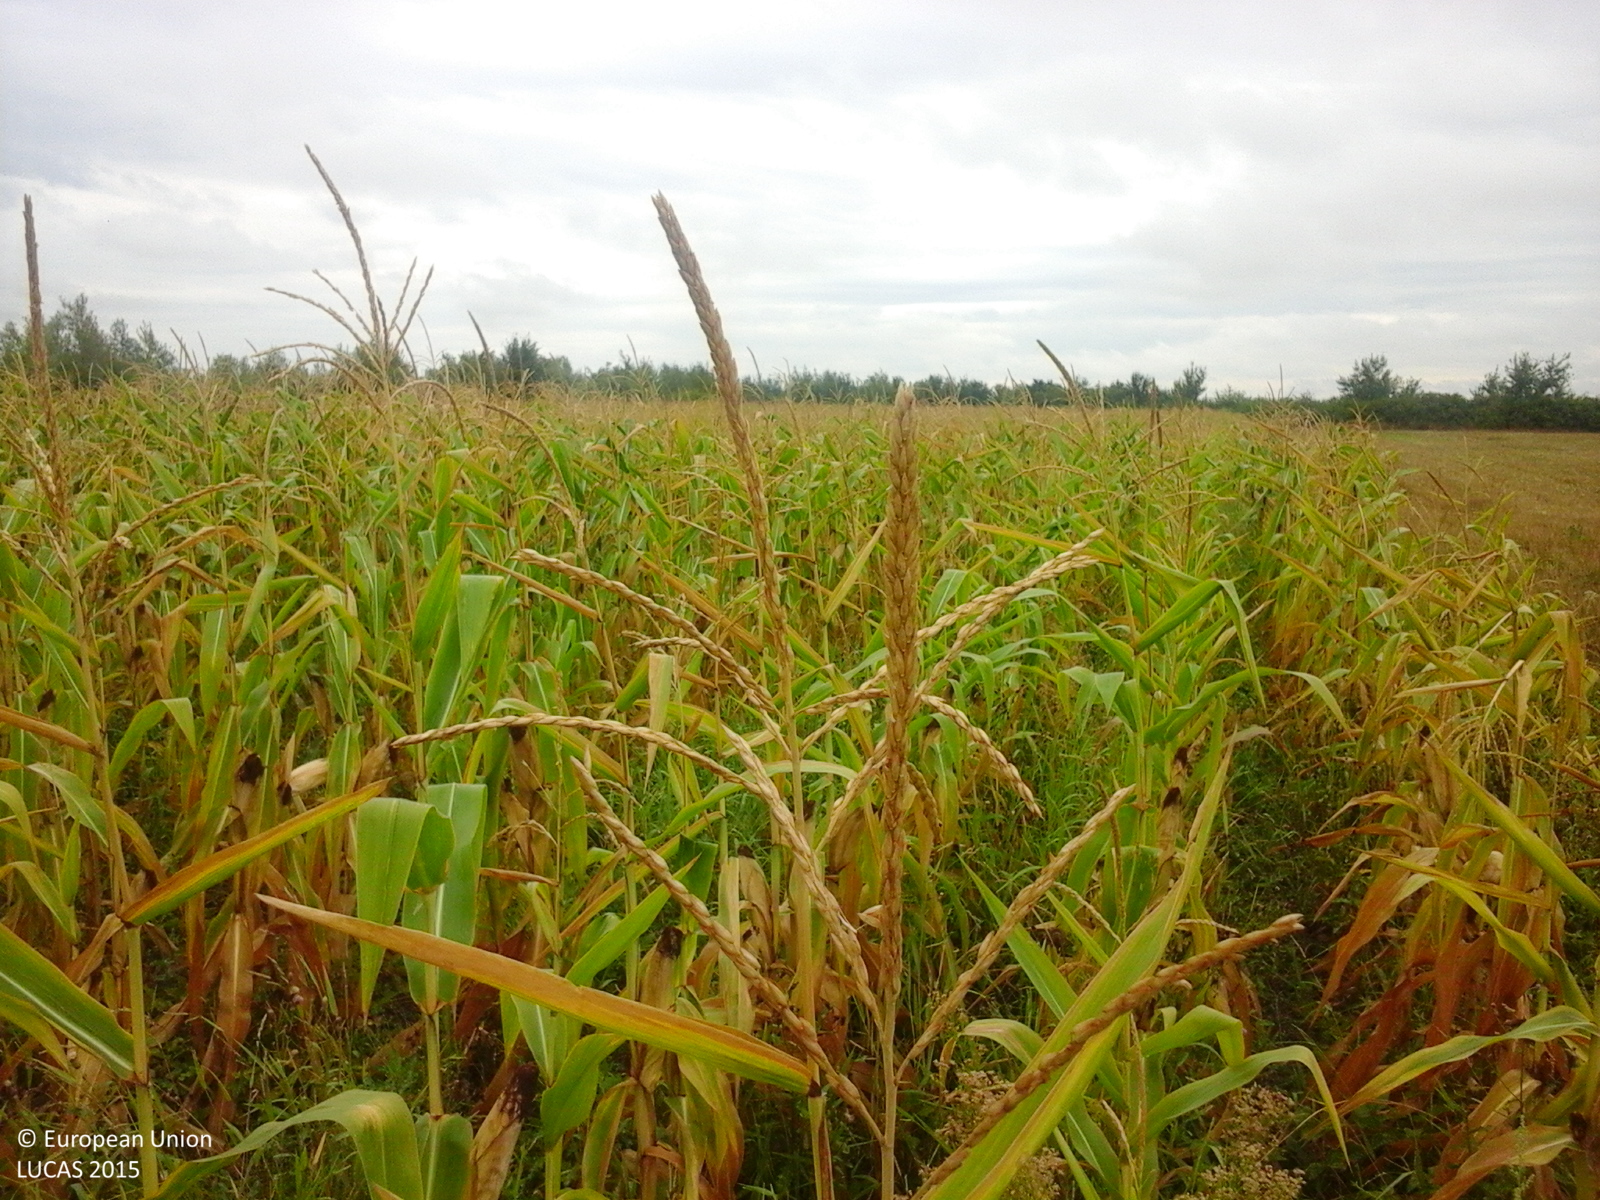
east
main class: Cropland
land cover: Maize
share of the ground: > 75 %
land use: Agriculture (excluding fallow land and kitchen gardens)
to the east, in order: Maize; Grass margins; Tracks; Grass margins; Shrubland with sparse tree cover; Arable land (only in case pi)
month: August
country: RO
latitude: 45.7621
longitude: 21.3595
